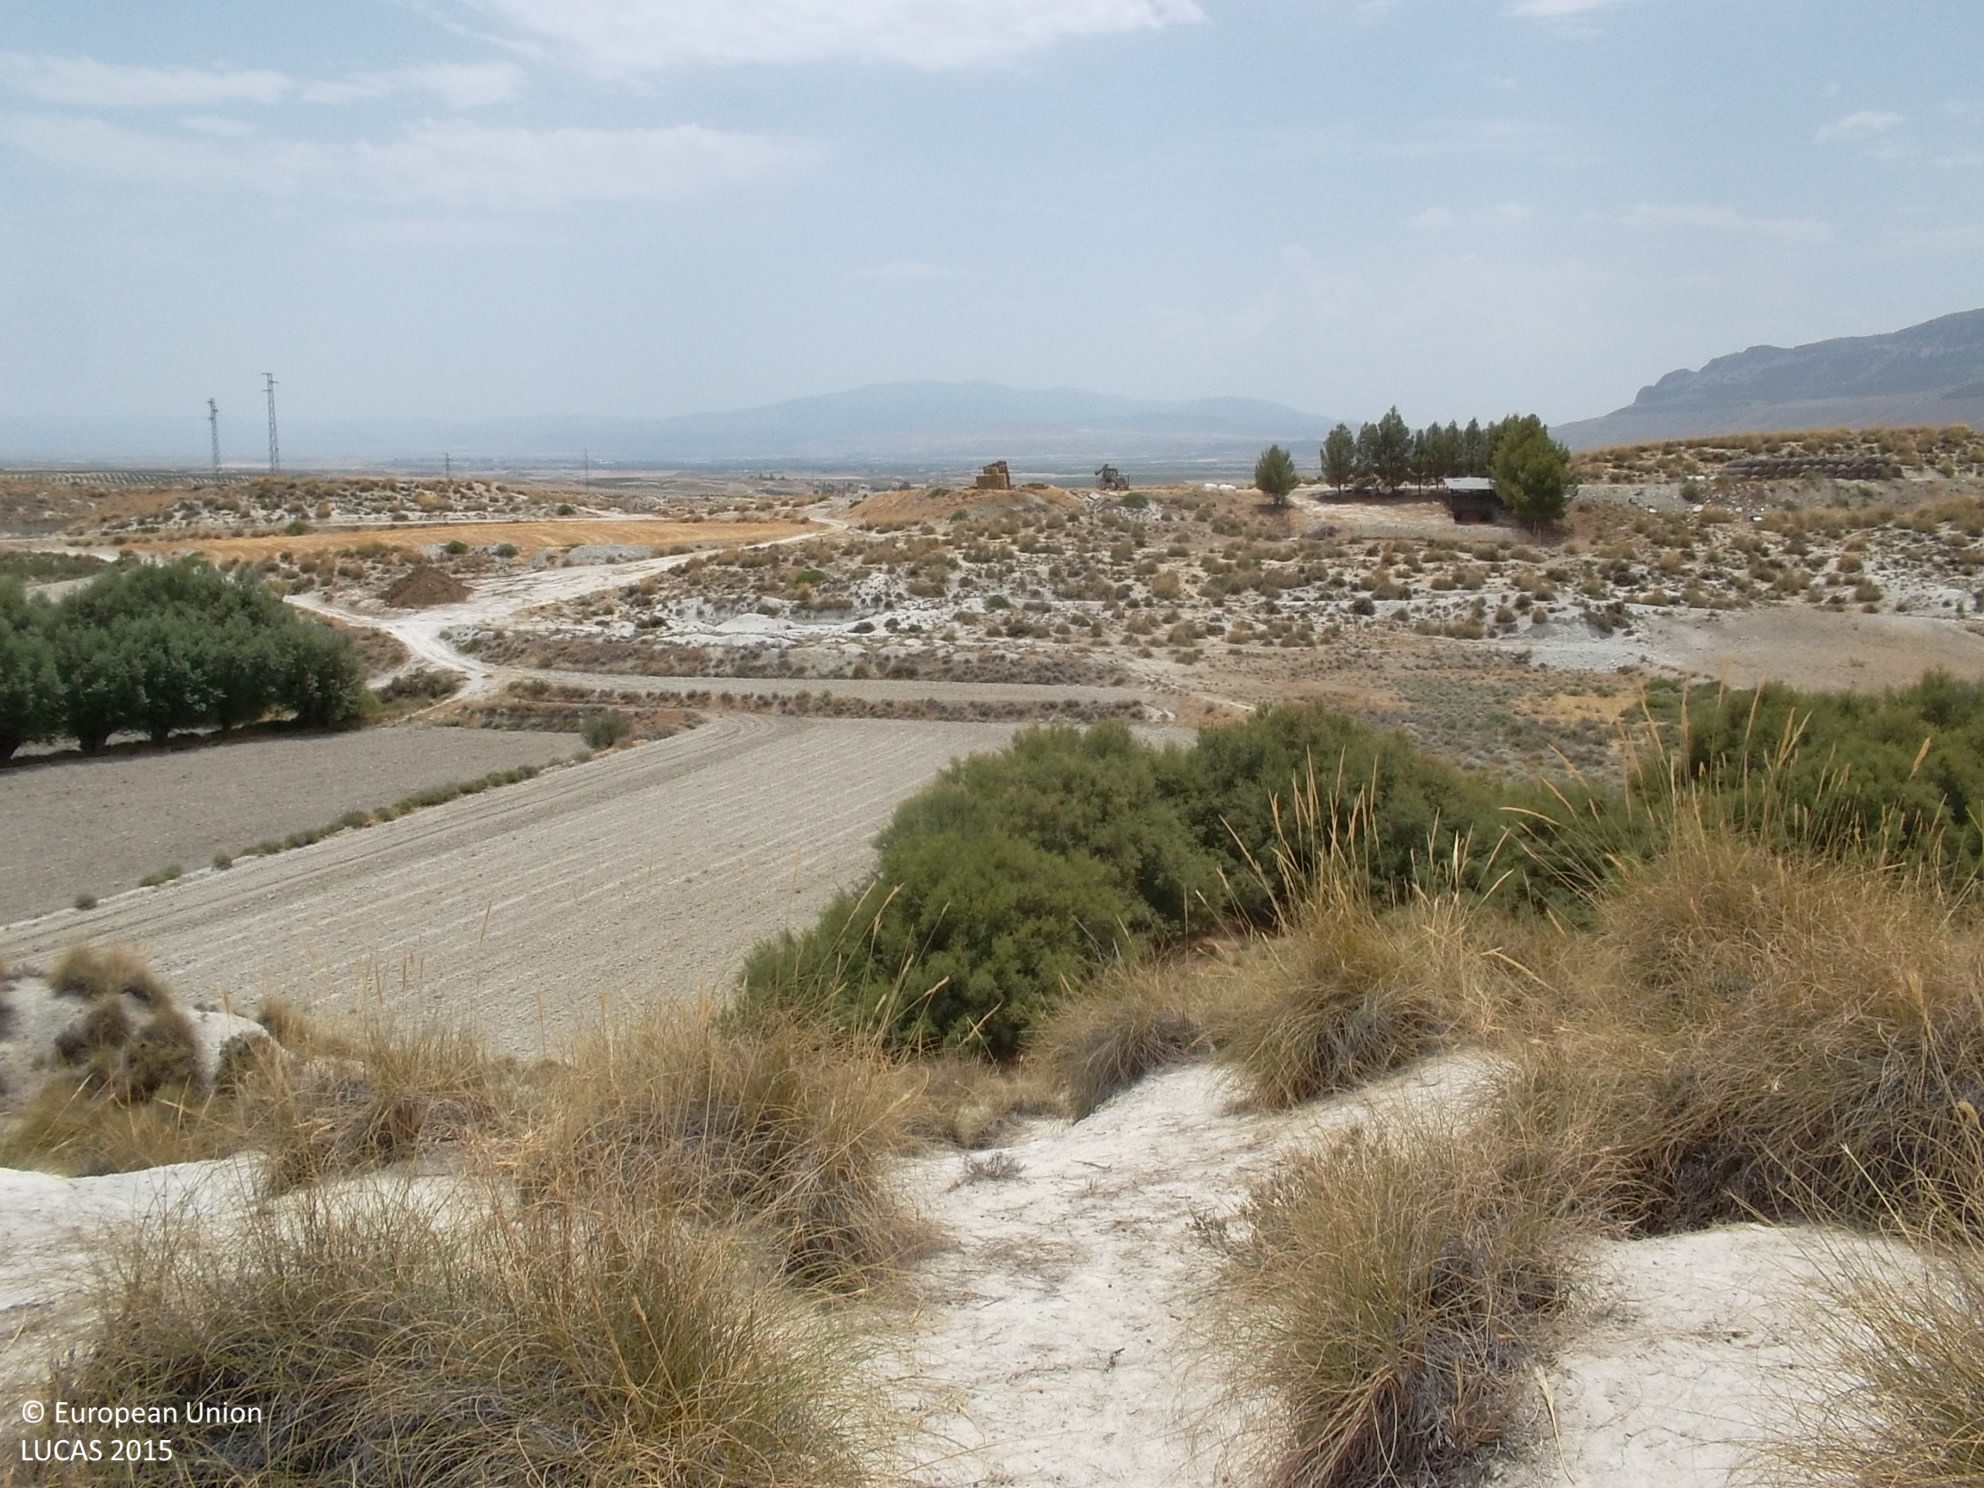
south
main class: Grassland
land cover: Grassland without tree/shrub cover
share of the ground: 25 - 50 %
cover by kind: unconsolidated bare surface 65 %, herbaceous plants 35 %
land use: Agriculture (excluding fallow land and kitchen gardens)
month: July
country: ES
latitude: 37.6209
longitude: -2.7347
